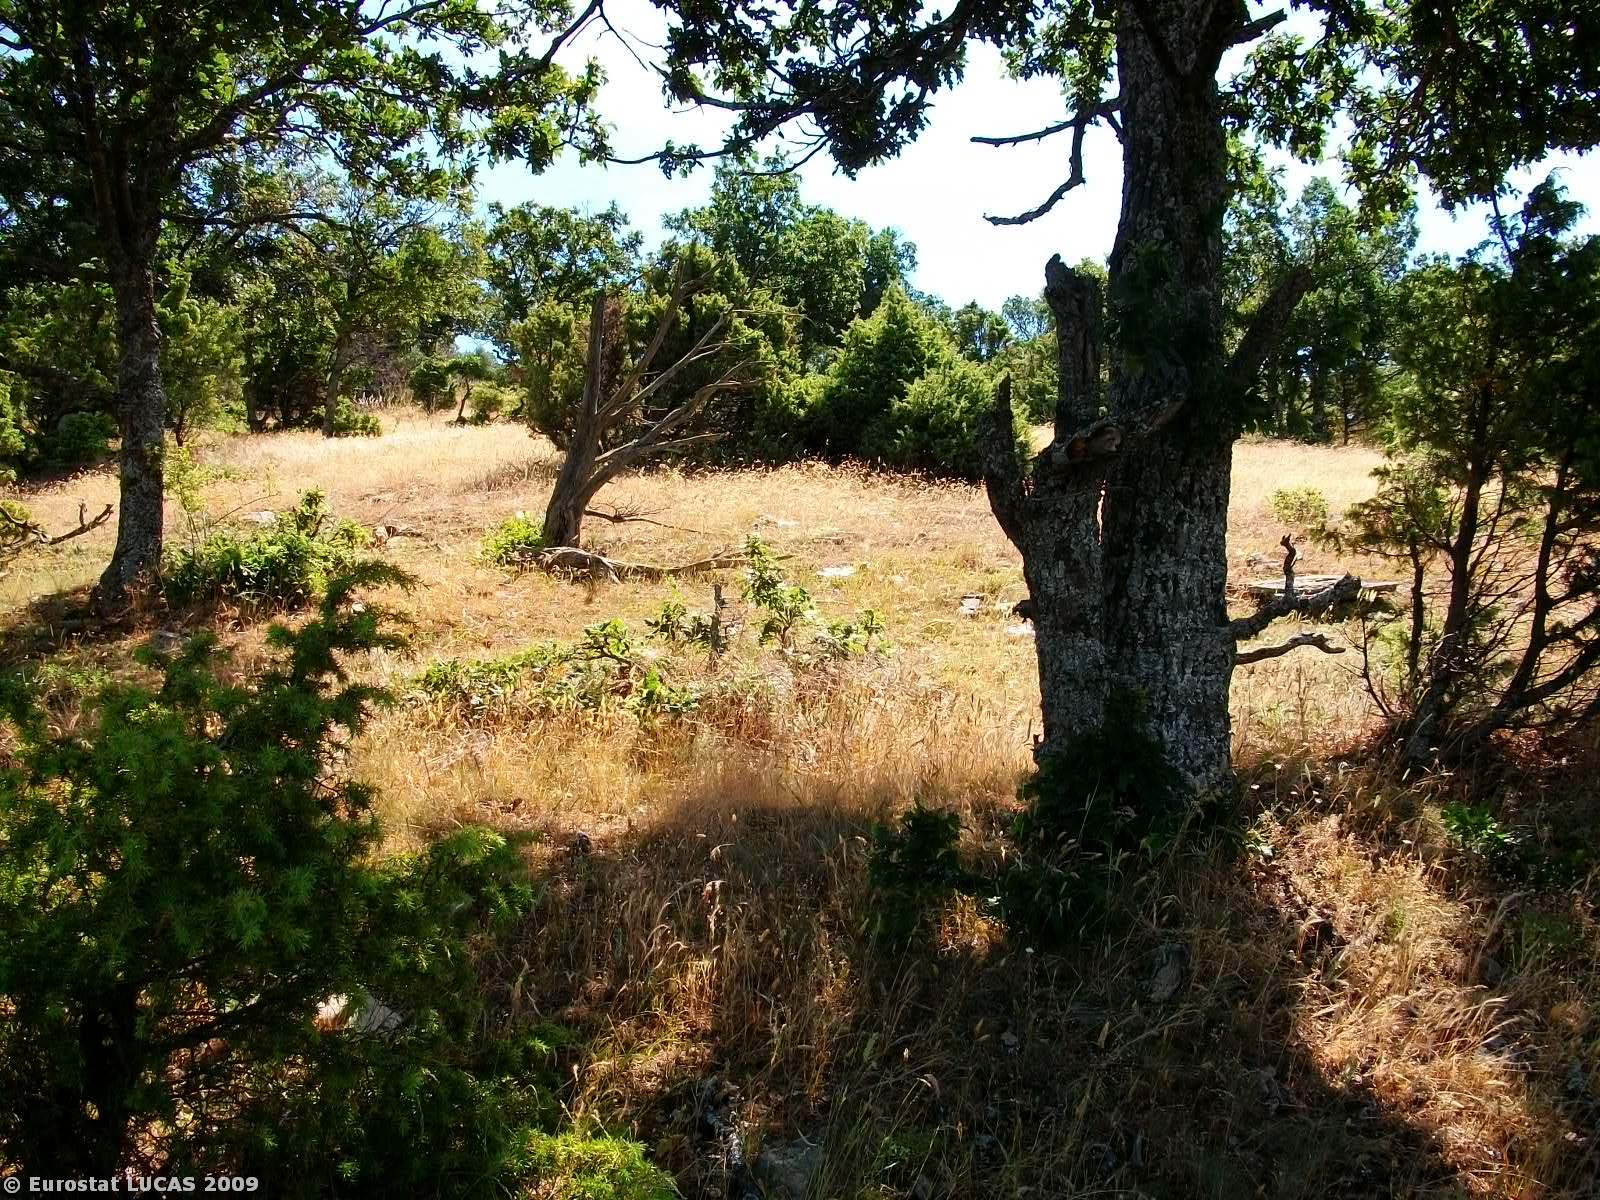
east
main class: Woodland
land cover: Broadleaved woodland
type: thermophilous deciduous forest
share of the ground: > 75 %
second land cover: Grassland with sparse tree/shrub cover
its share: > 75 %
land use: Agriculture (excluding fallow land and kitchen gardens)
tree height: > 5 m
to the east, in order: Broadleaved woodland; Grassland with sparse tree/shrub cover; Broadleaved woodland
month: June
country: GR
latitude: 41.1403
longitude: 25.8453
